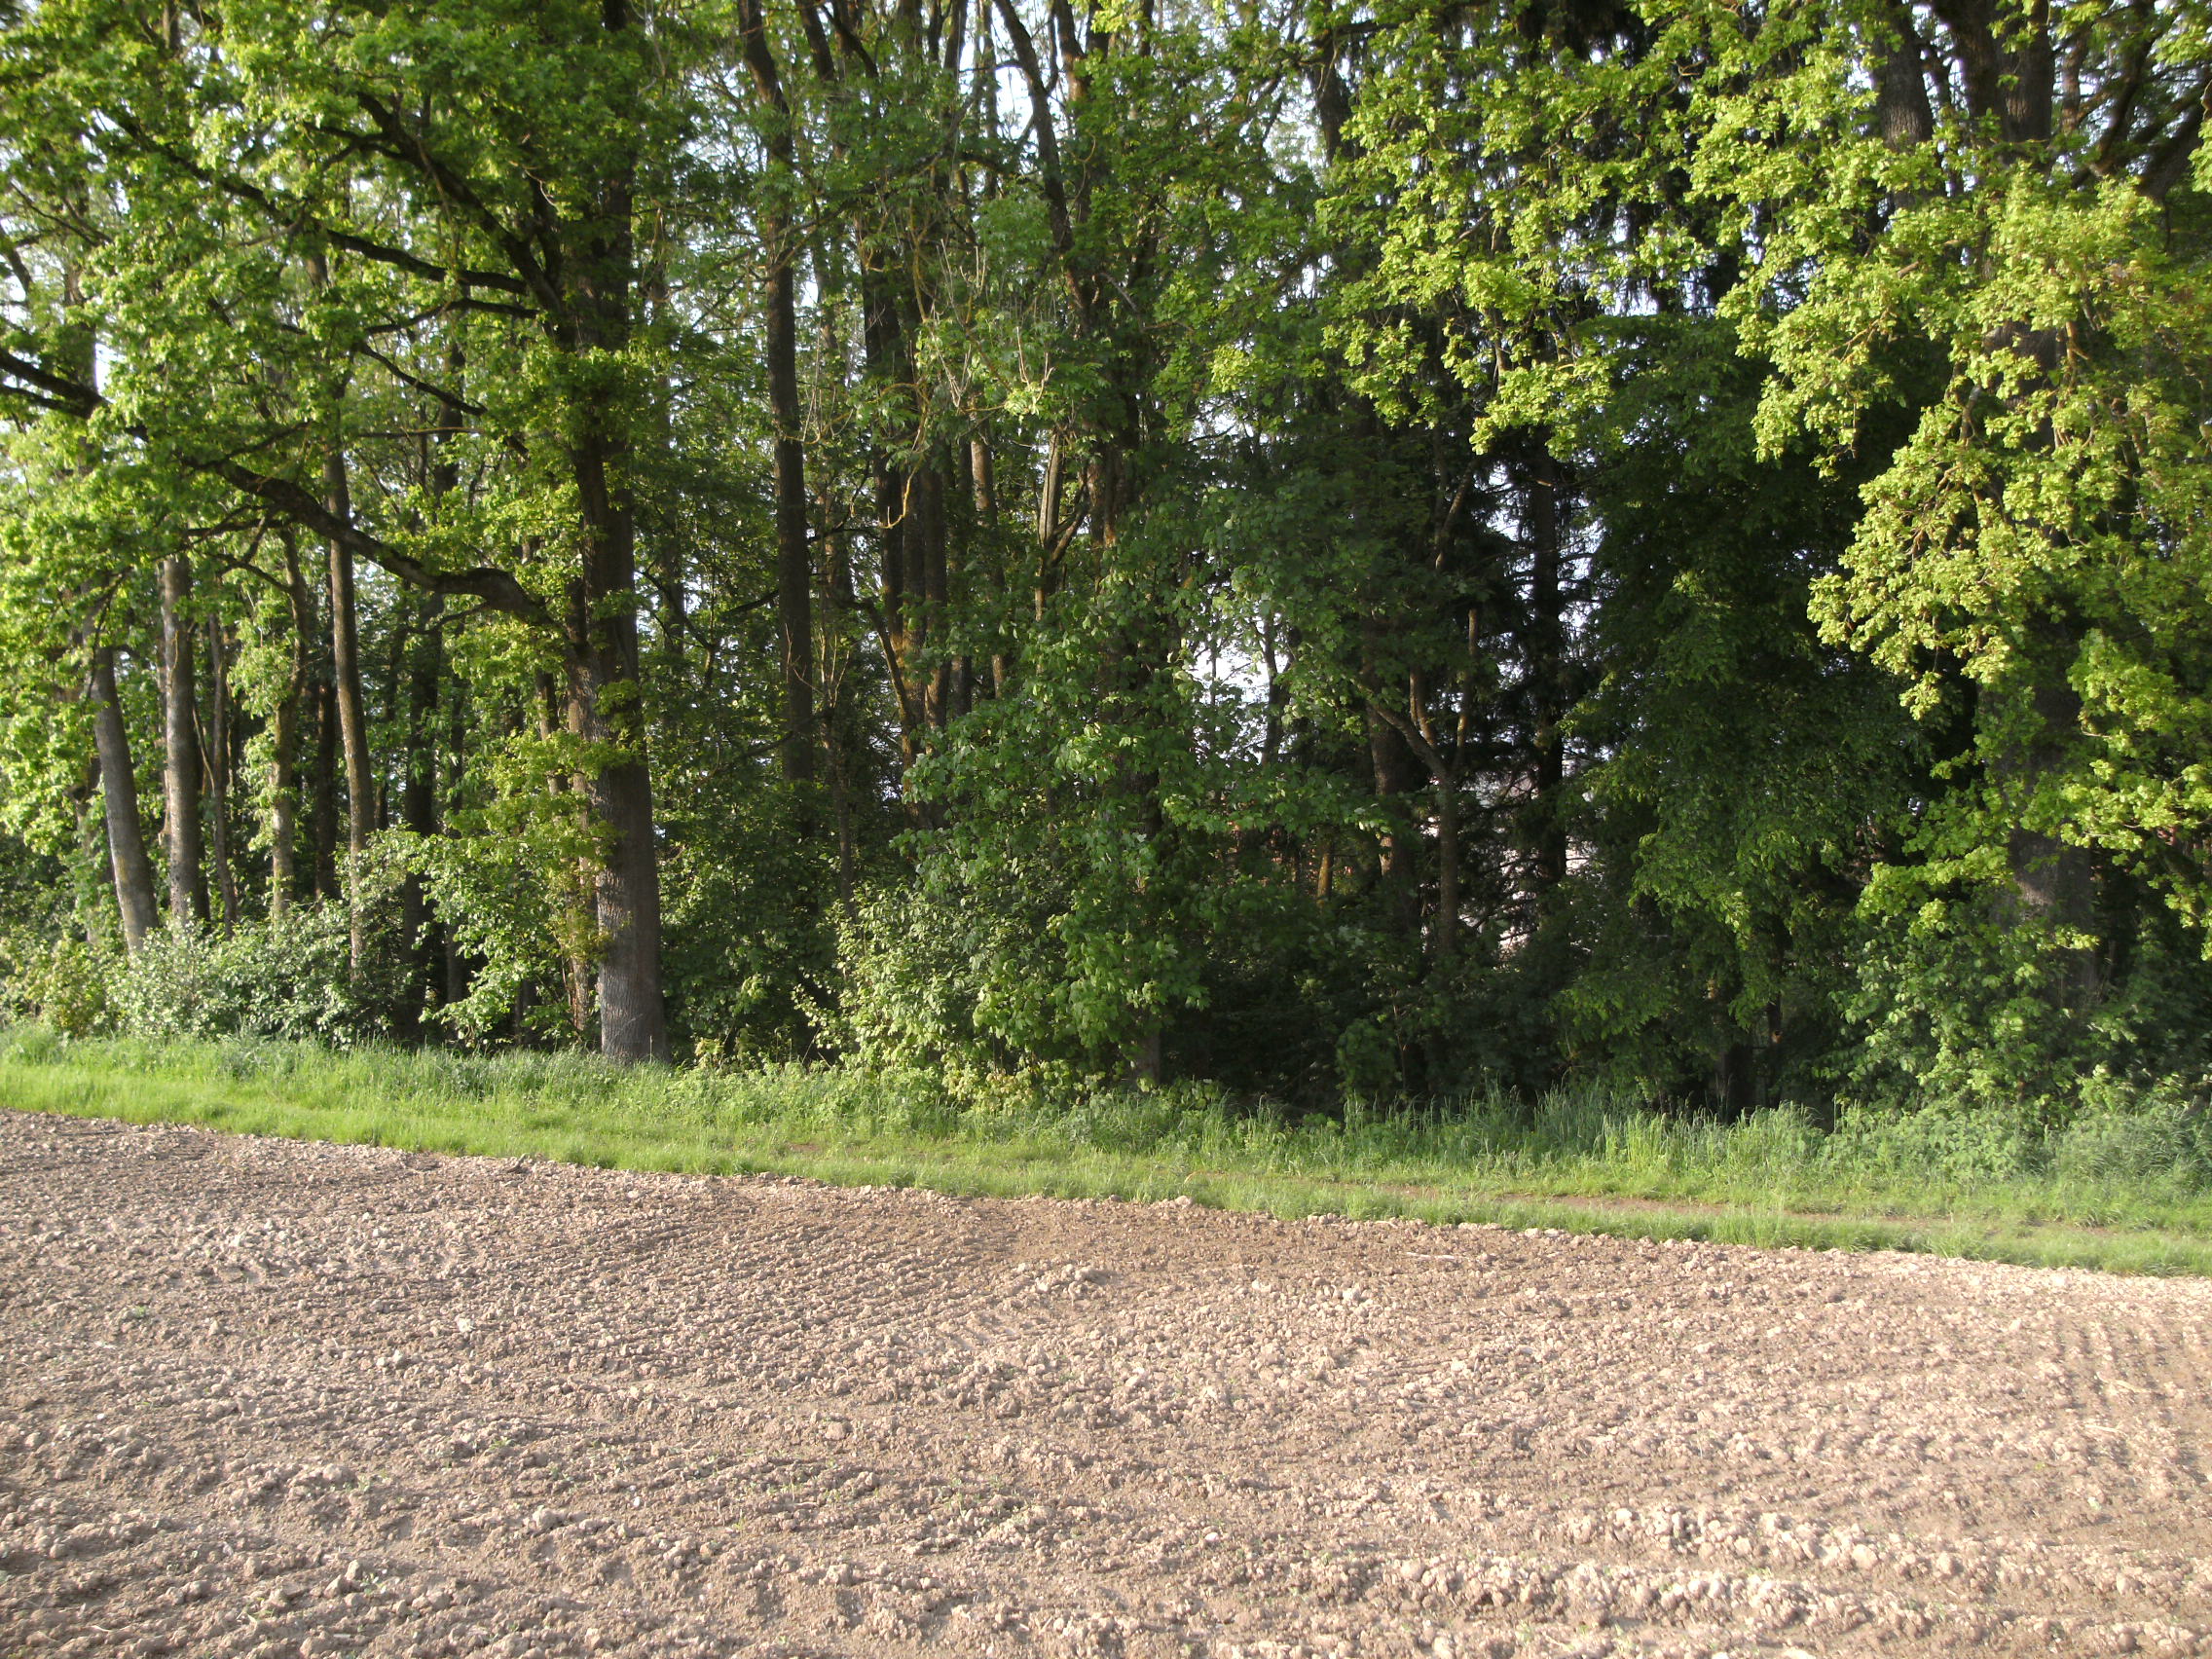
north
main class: Cropland
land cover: Soya
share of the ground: < 10 %
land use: Agriculture (excluding fallow land and kitchen gardens)
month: May
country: AT
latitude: 48.3583
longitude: 13.7380
